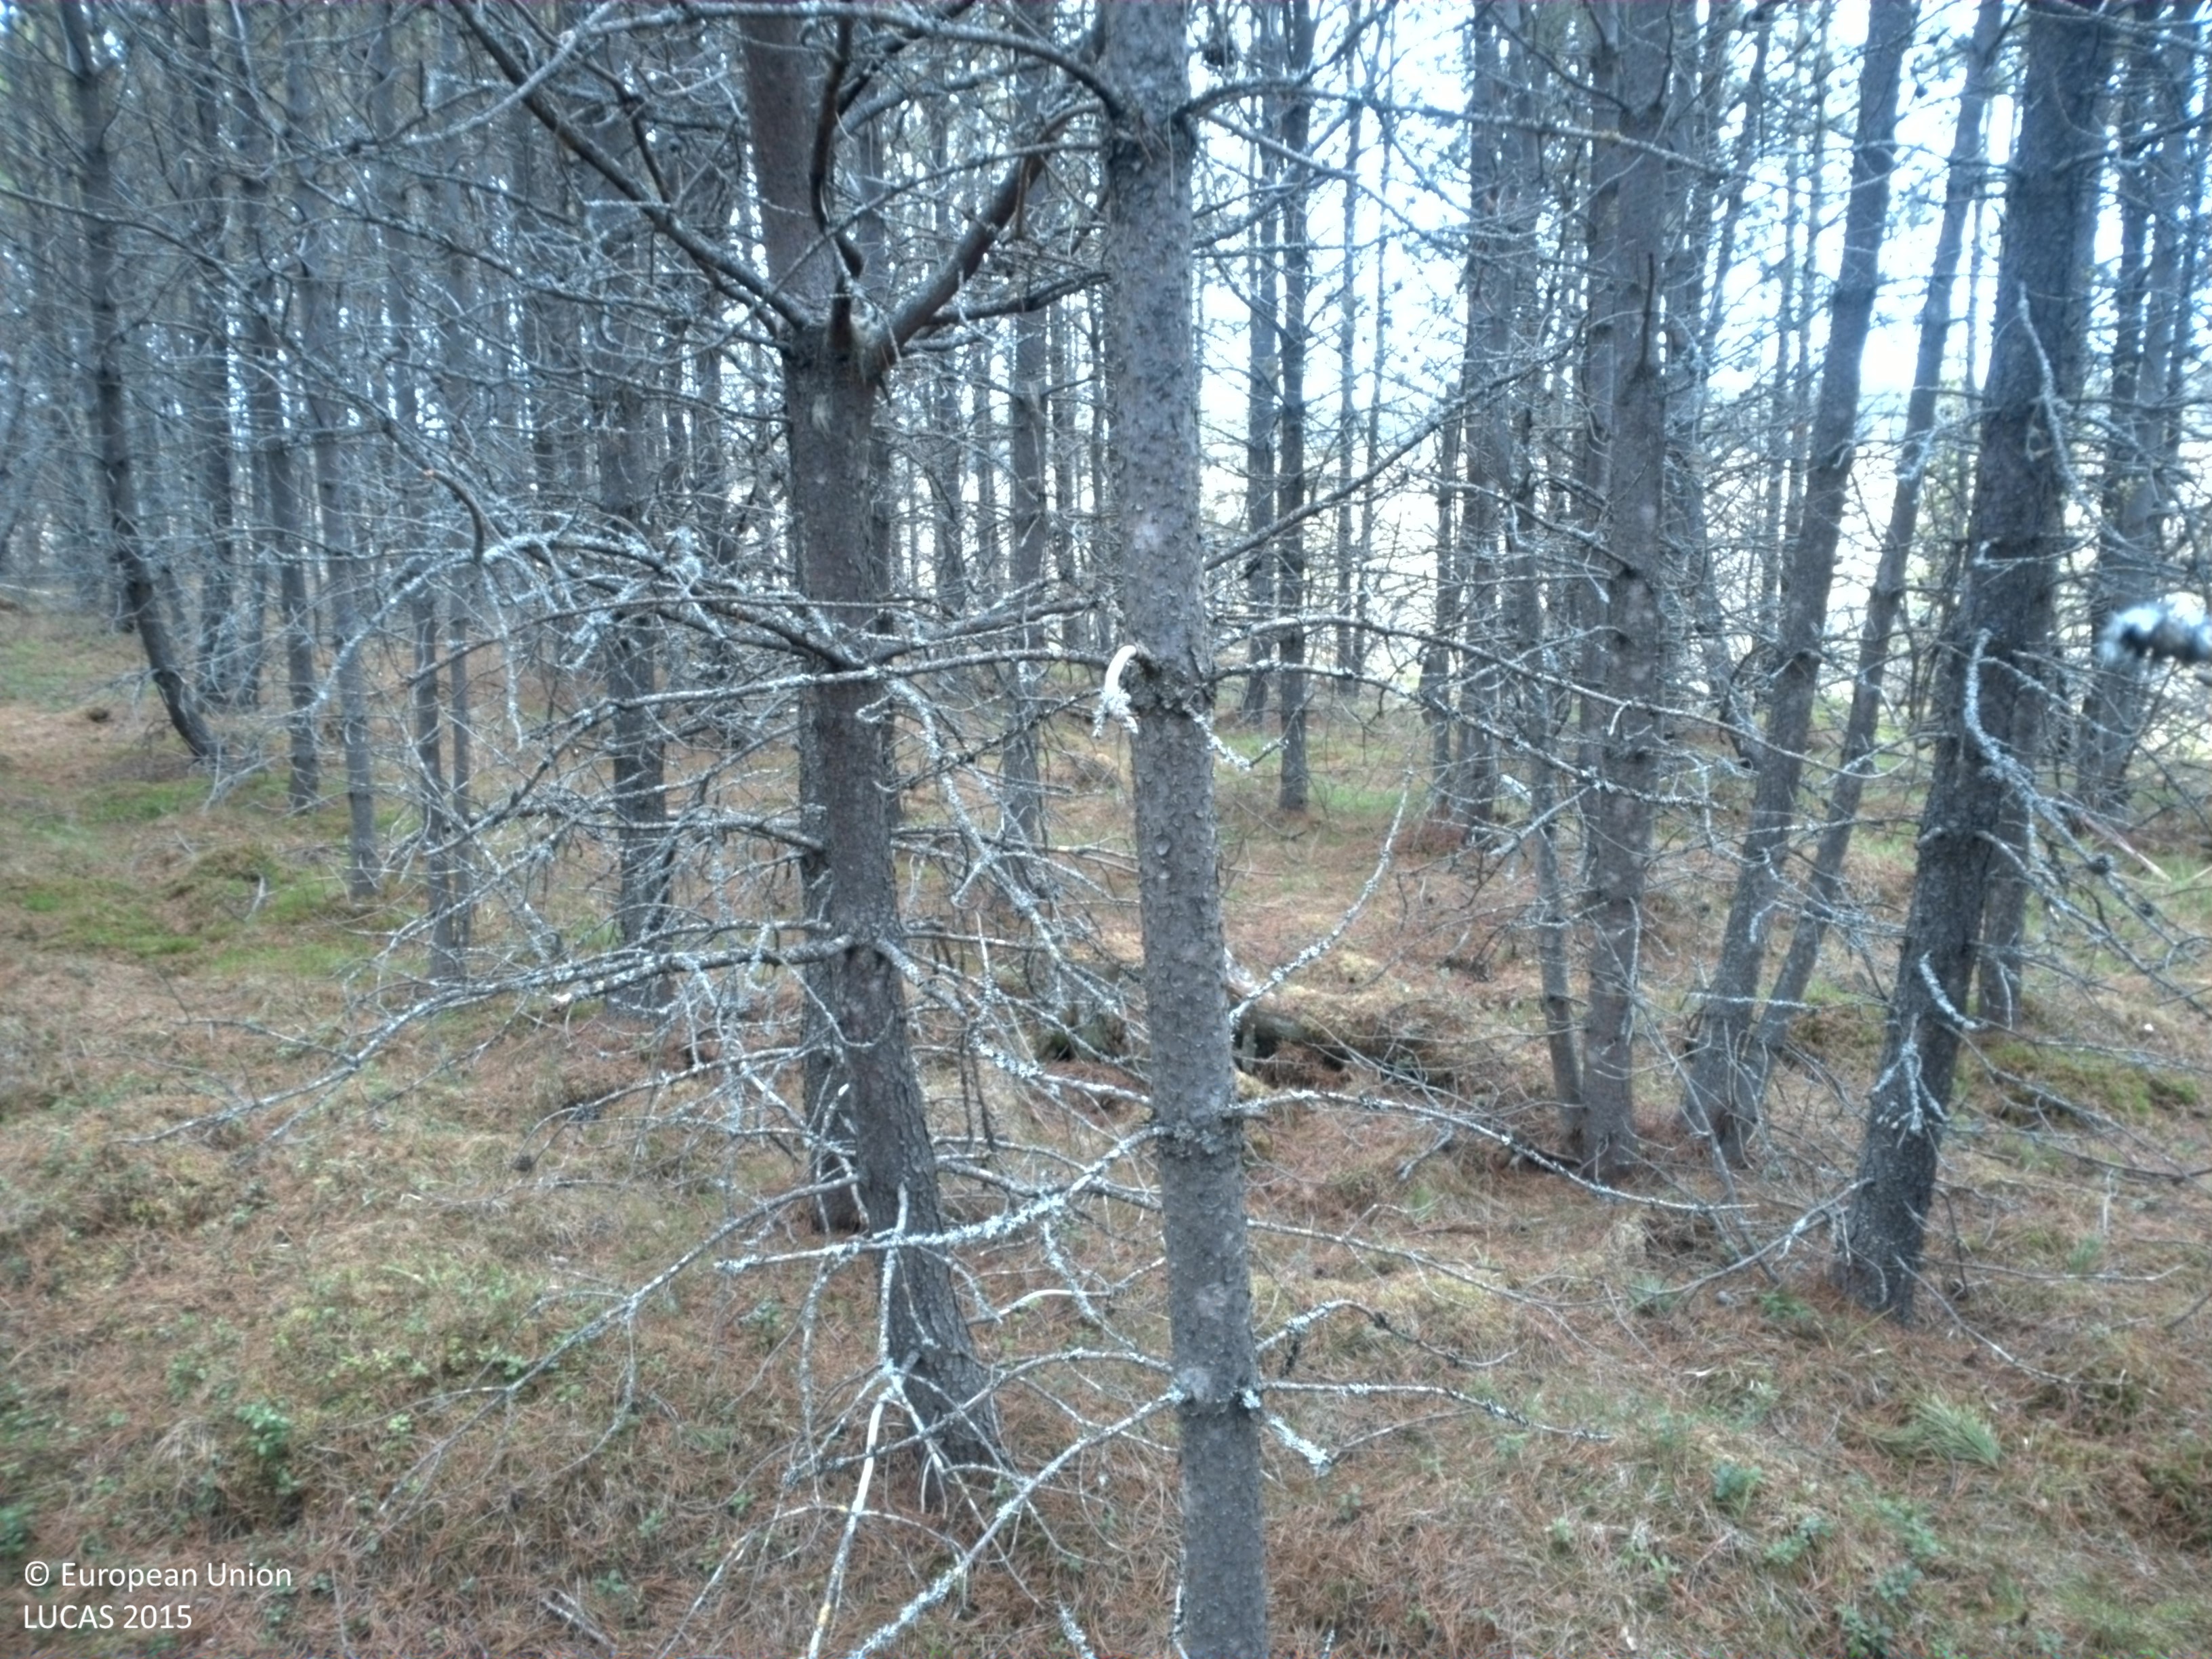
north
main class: Woodland
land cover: Pine dominated coniferous woodland
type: exotic forest
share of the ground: 50 - 75 %
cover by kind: coniferous forest trees 50 %, lichens and mosses 30 %, herbaceous plants 10 %, broadleaved forest trees 5 %, shrubs 5 %
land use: Forestry
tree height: > 5 m
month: June
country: SE
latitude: 64.3108
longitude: 17.5151
